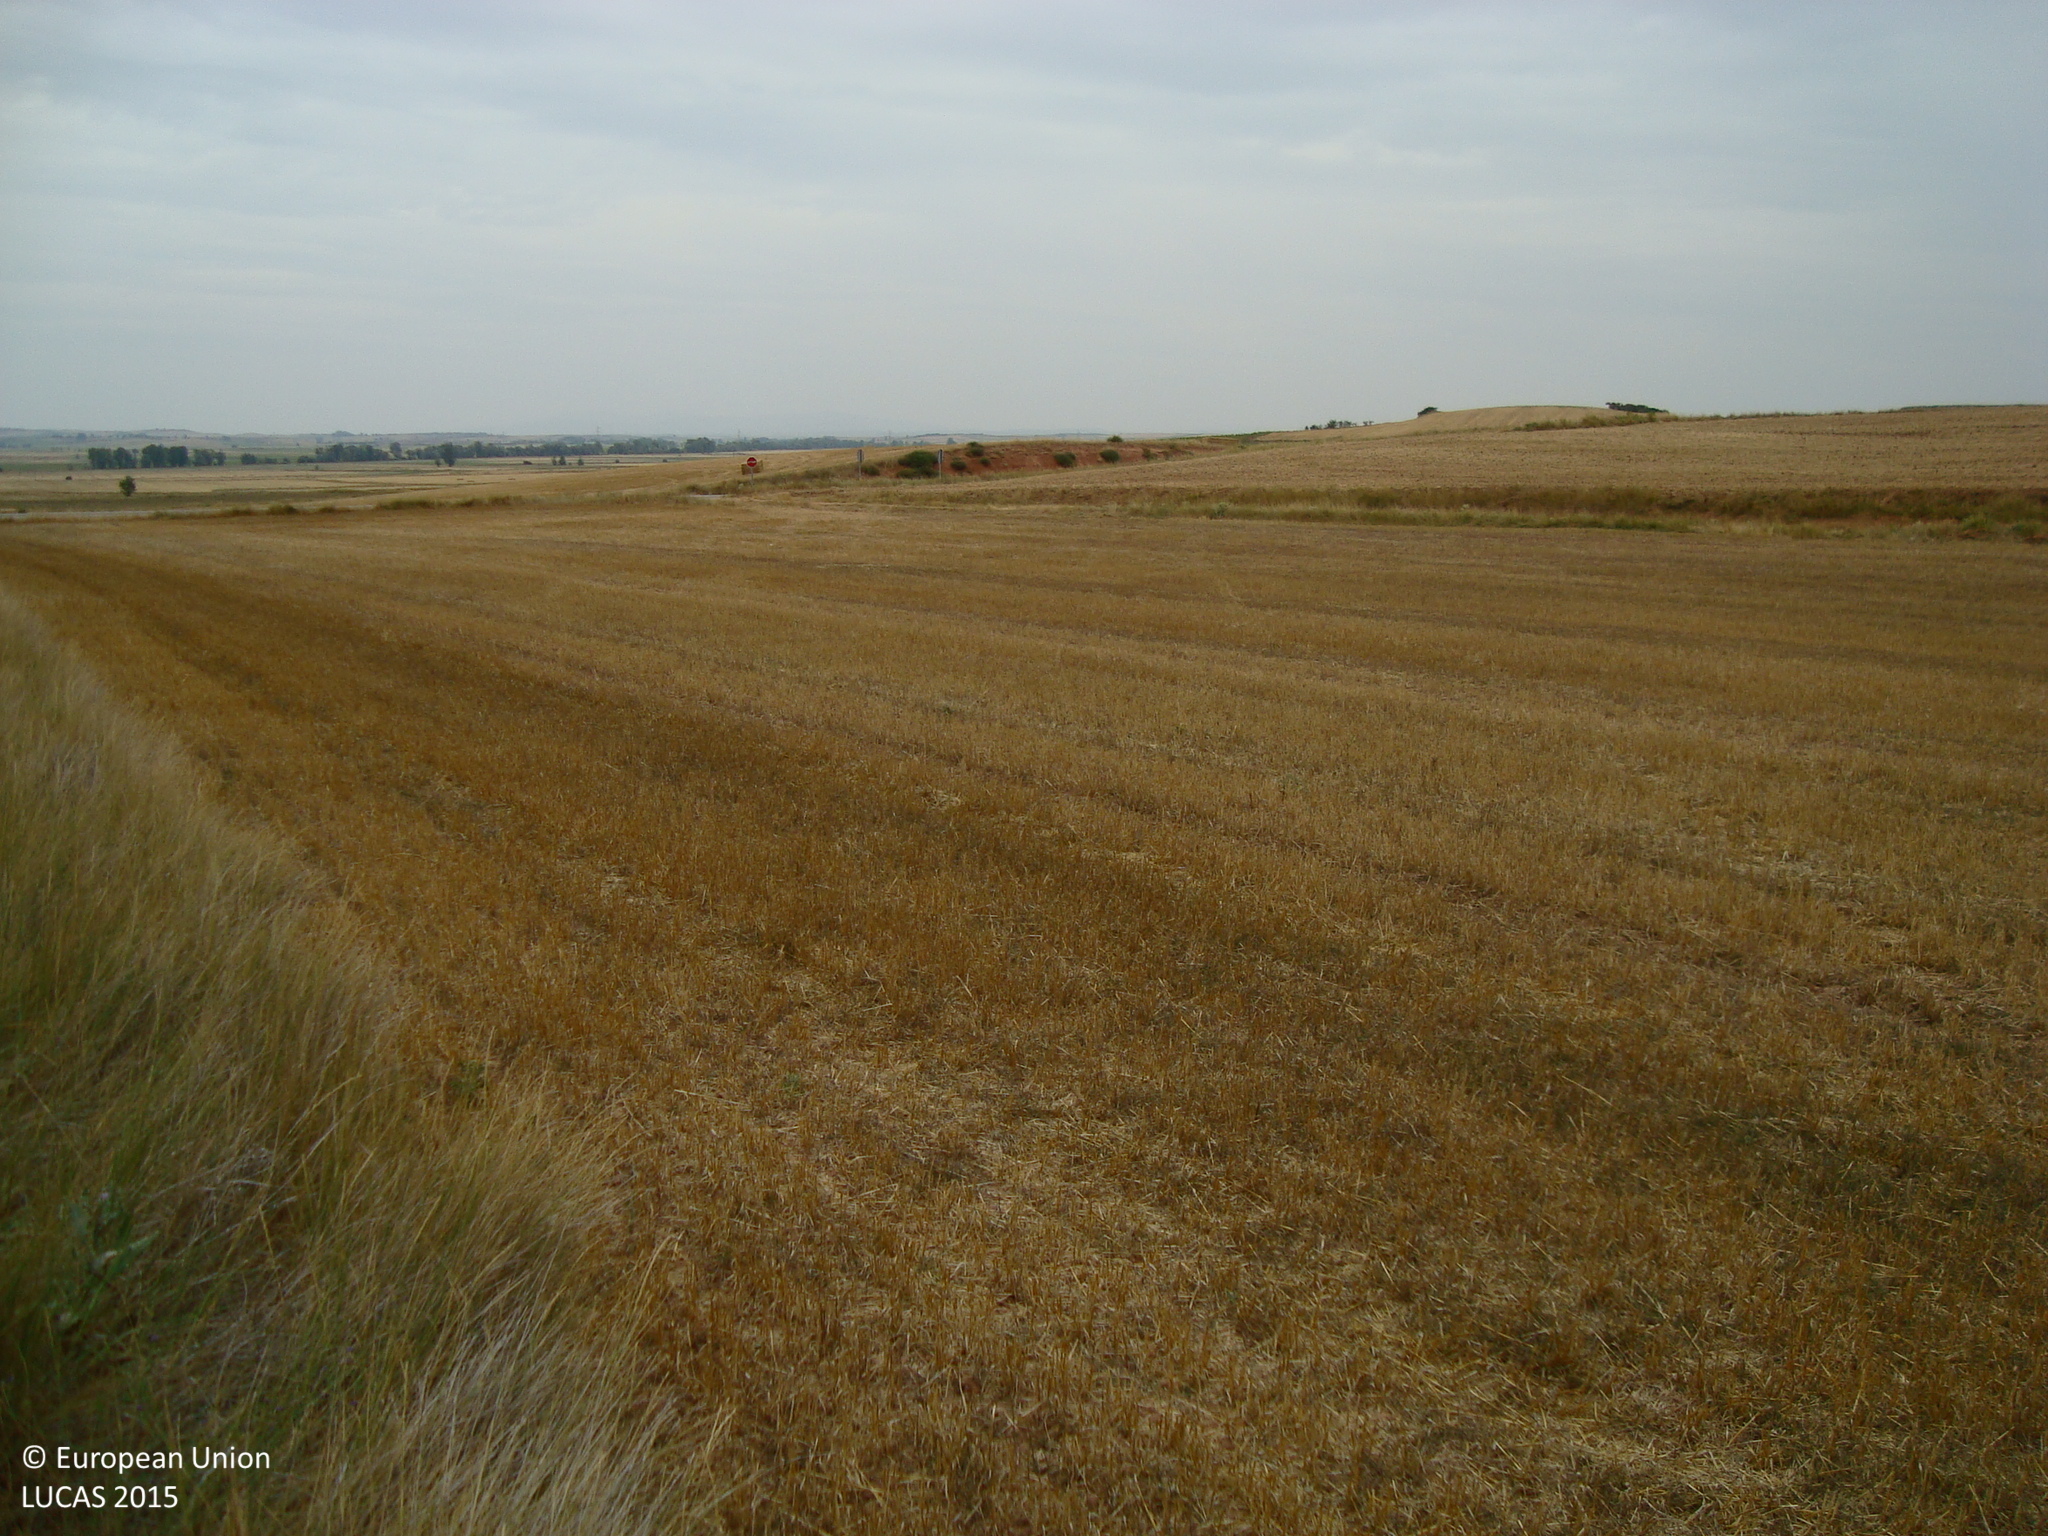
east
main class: Cropland
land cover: Barley
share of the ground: > 75 %
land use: Agriculture (excluding fallow land and kitchen gardens)
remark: Harvested field
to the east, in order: Rivers and streams; Barley; Tracks; Other bare soil; Paved roads, cycling and walking lanes; Barley
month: August
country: ES
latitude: 42.1743
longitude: -3.9725
